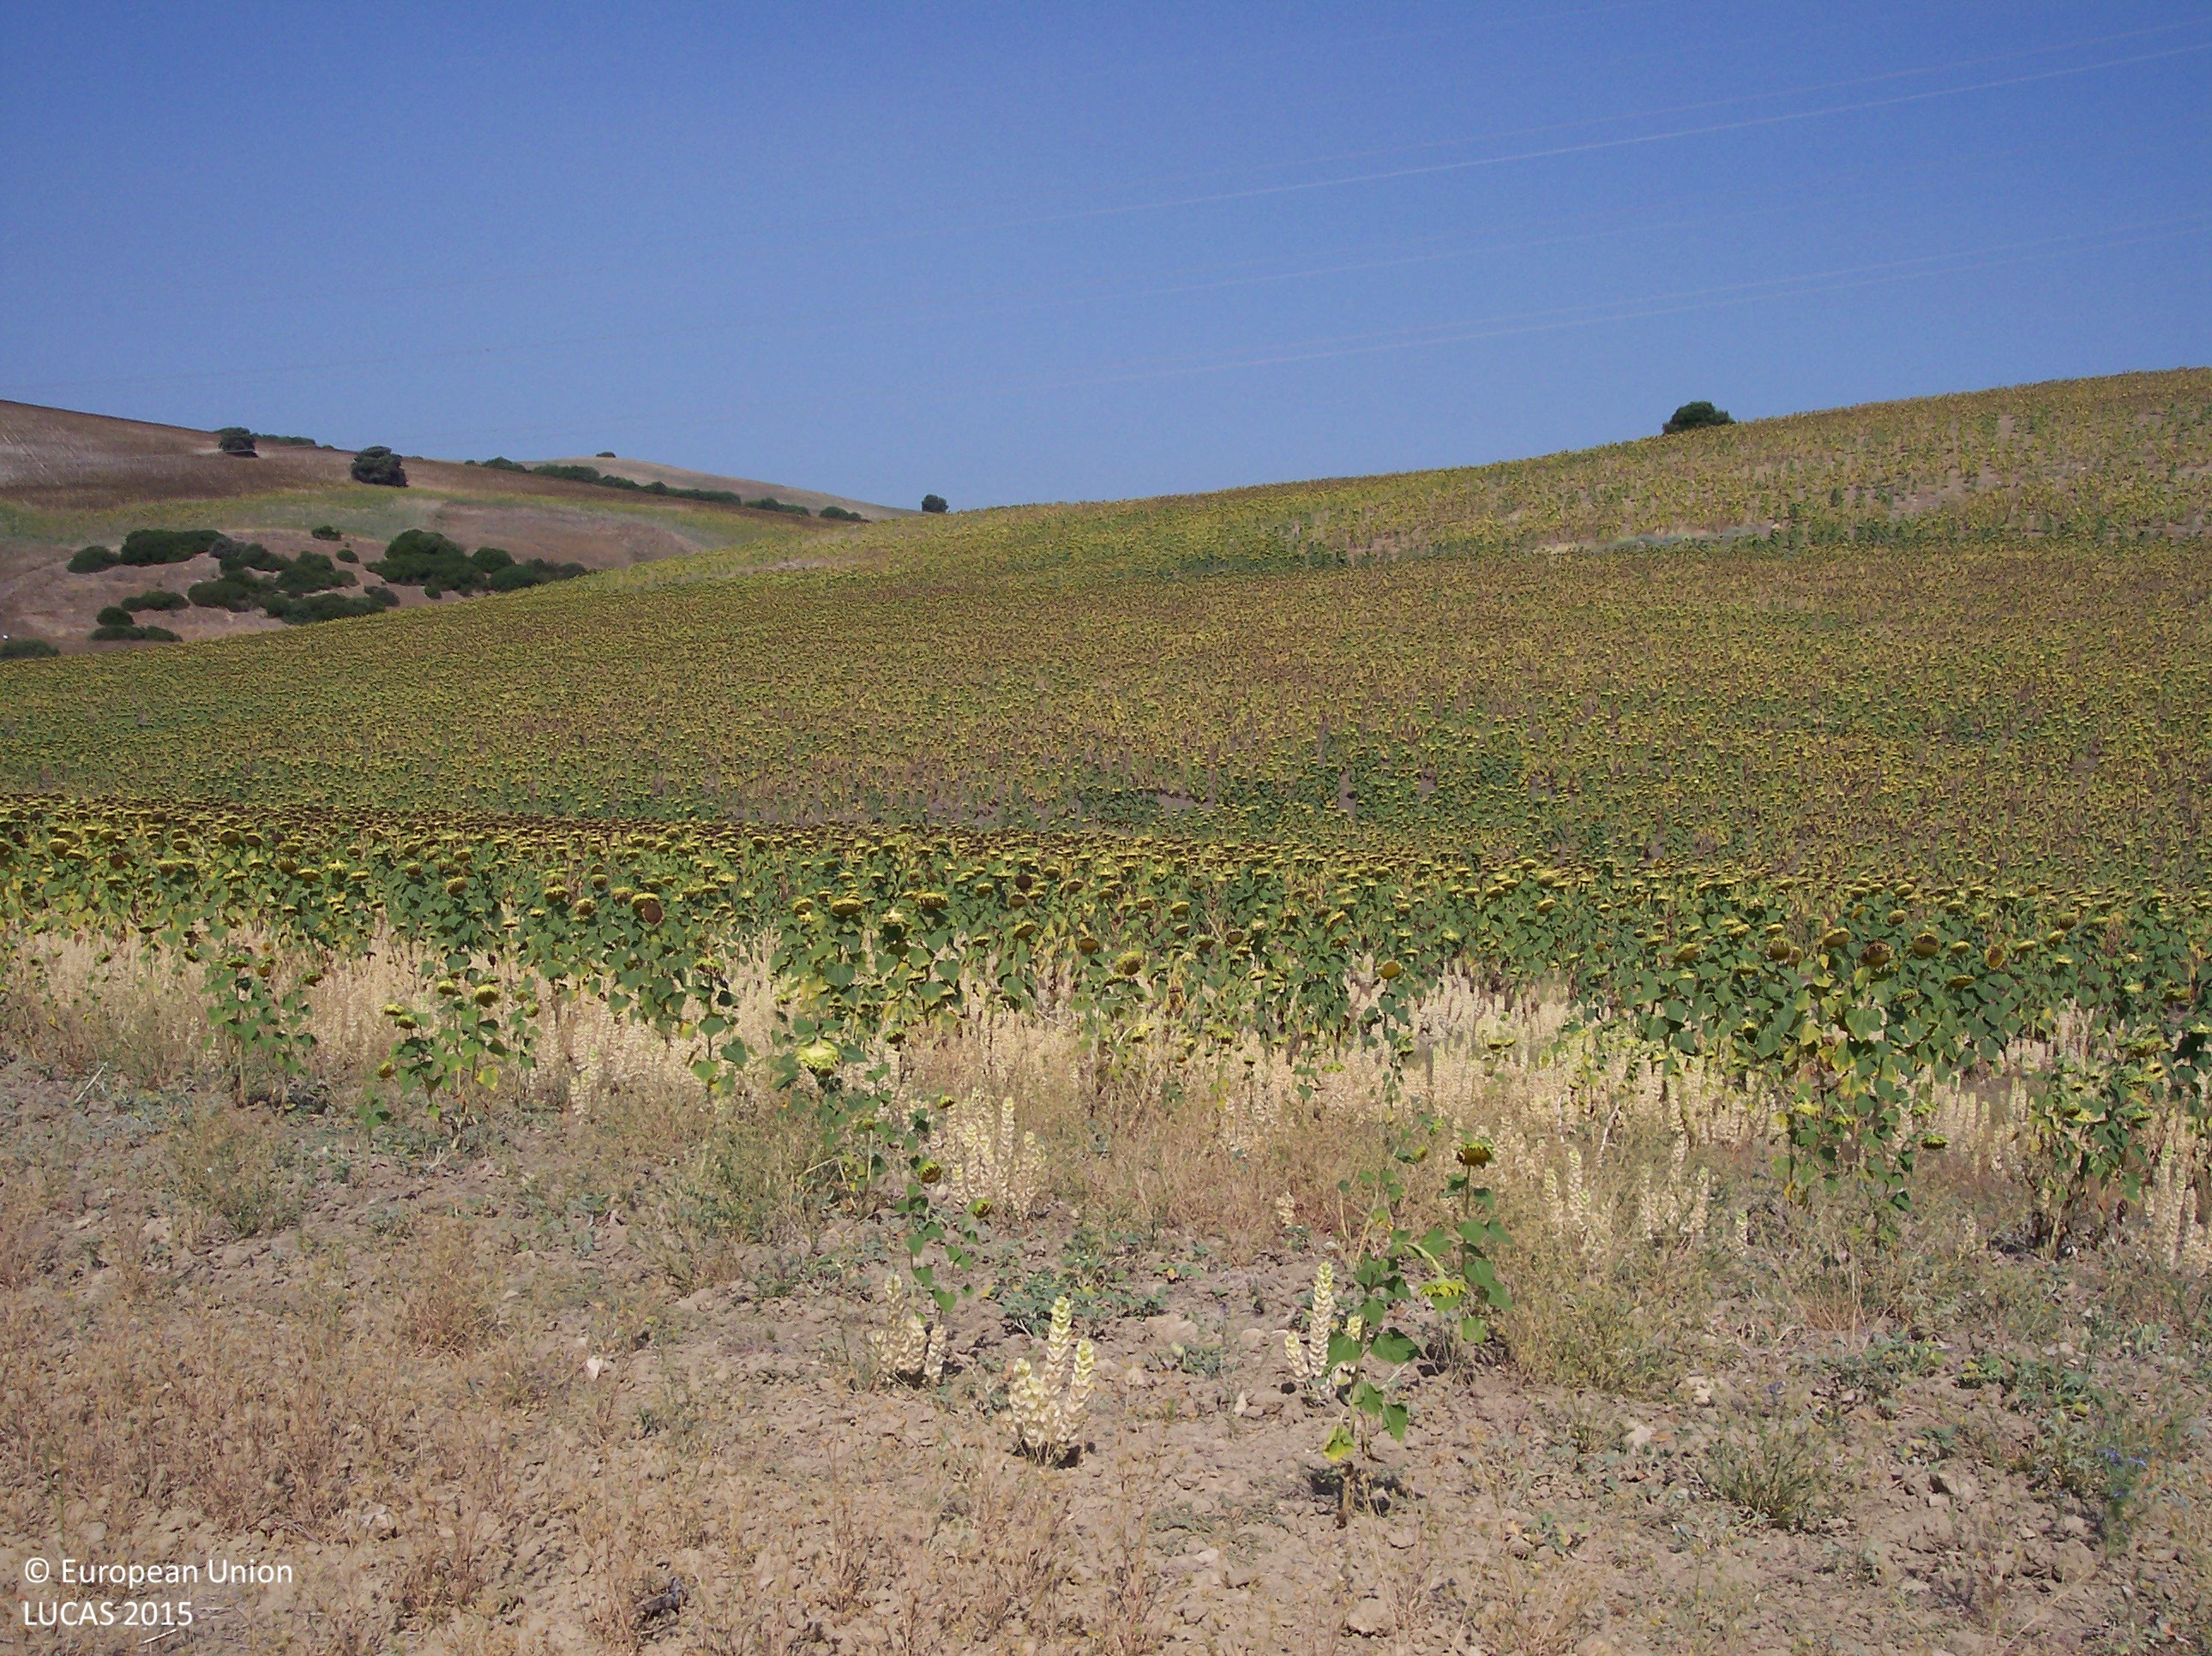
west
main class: Shrubland
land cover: Shrubland without tree cover
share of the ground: > 75 %
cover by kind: shrubs 90 %, herbaceous plants 5 %, unconsolidated bare surface 5 %
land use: Semi-natural and natural areas not in use
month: July
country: ES
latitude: 36.9893
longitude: -5.7987
